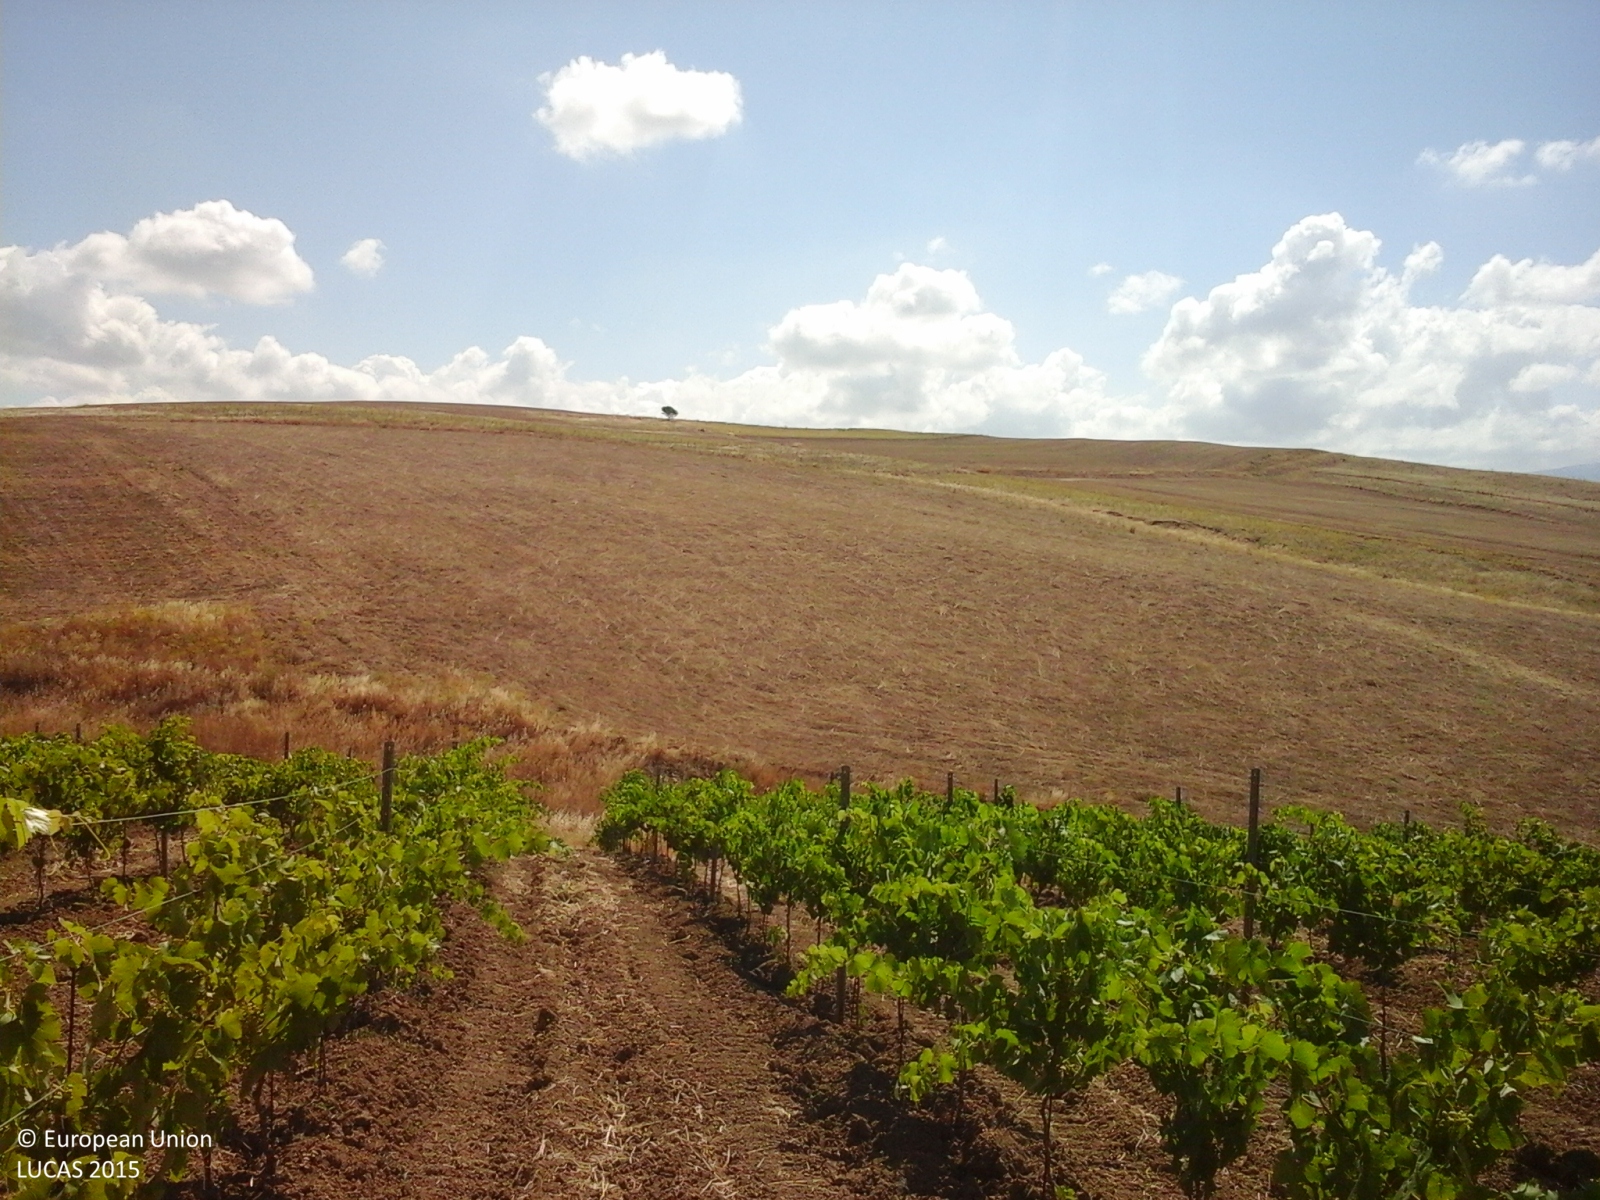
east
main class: Cropland
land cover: Vineyards
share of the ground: 25 - 50 %
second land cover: Other bare soil
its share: > 75 %
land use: Agriculture (excluding fallow land and kitchen gardens)
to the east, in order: Vineyards; Other bare soil; Grass margins; Tracks; Grass margins; Spontaneously vegetated surfaces; Rivers and streams; Spontaneously vegetated surfaces; Durum wheat
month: June
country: IT
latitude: 37.7552
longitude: 12.9856
